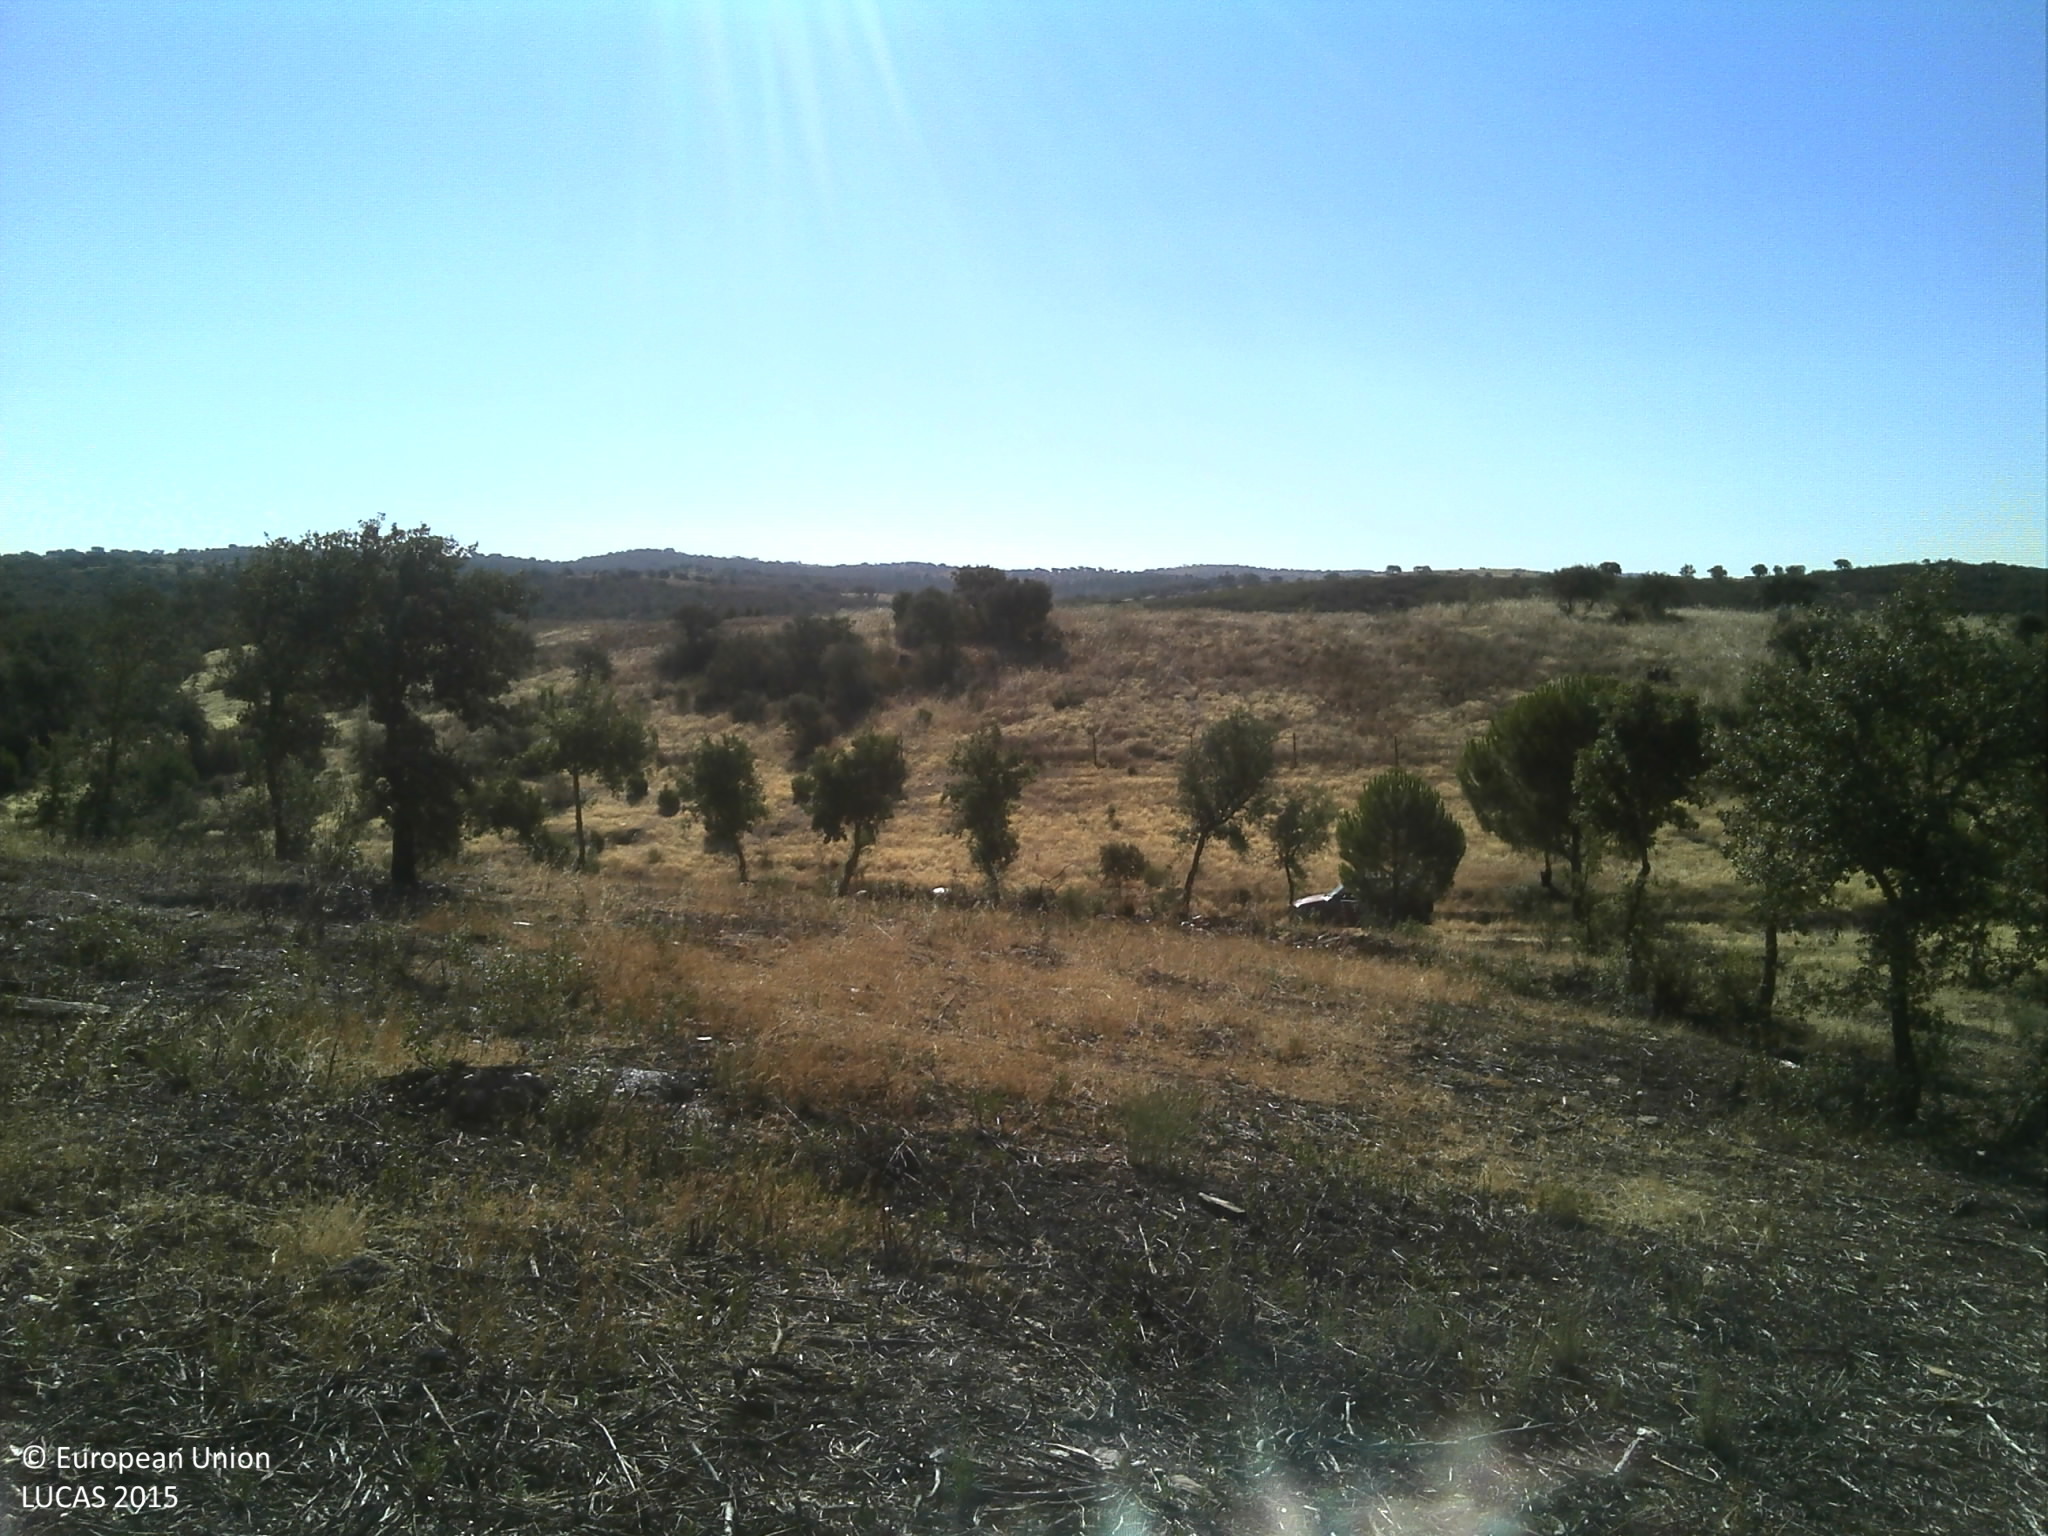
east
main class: Woodland
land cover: Pine dominated coniferous woodland
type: coniferous forest of the mediterranean region
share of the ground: 10 - 25 %
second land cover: Grassland without tree/shrub cover
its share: 25 - 50 %
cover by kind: unconsolidated bare surface 55 %, coniferous forest trees 25 %, herbaceous plants 20 %
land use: Forestry
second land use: Agriculture (excluding fallow land and kitchen gardens)
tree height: > 5 m
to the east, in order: Pine dominated coniferous woodland; Grassland without tree/shrub cover; Other mixed woodland; Grassland with sparse tree/shrub cover; Tracks; Shrubland without tree cover; Fences; Pine dominated coniferous woodland; Grassland with sparse tree/shrub cover; Fences; Broadleaved woodland; Shrubland with sparse tree cover
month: July
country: PT
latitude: 38.9364
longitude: -7.5146
